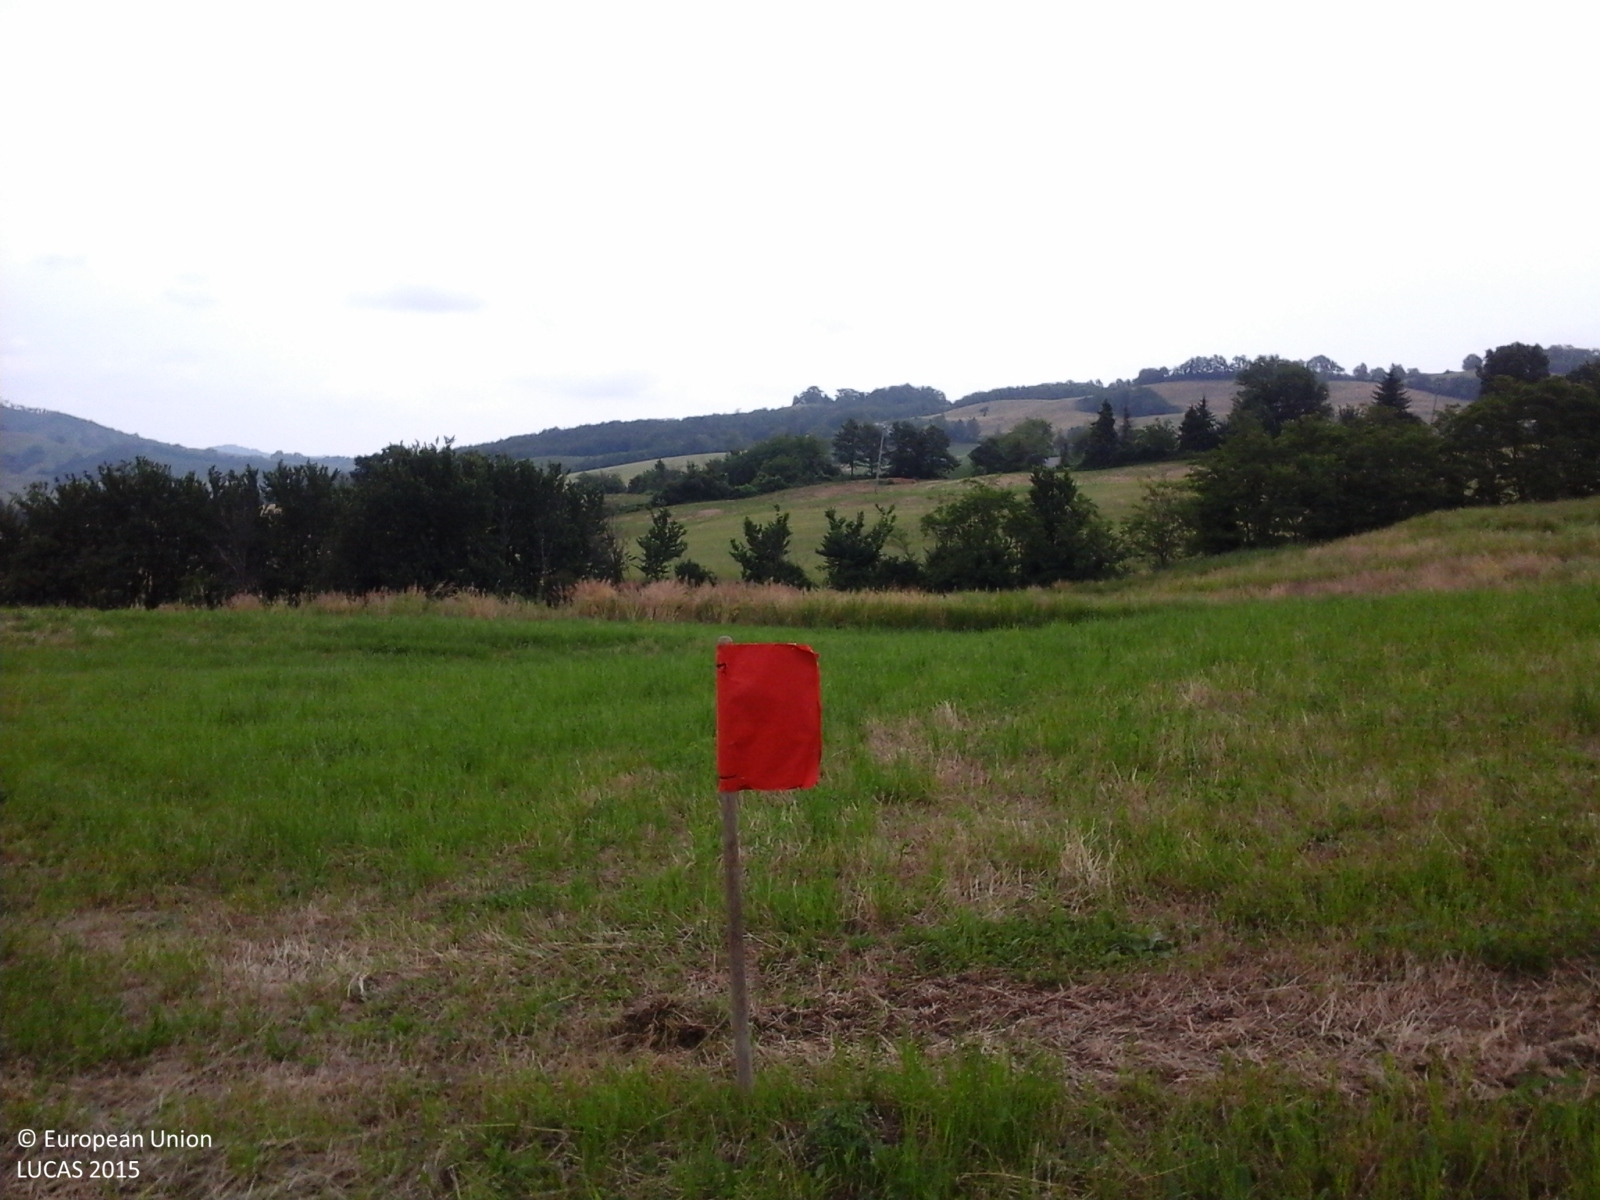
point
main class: Grassland
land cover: Grassland without tree/shrub cover
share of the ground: > 75 %
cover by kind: herbaceous plants 100 %
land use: Agriculture (excluding fallow land and kitchen gardens)
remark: Harvested field
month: May
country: IT
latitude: 44.6210
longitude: 10.1132
